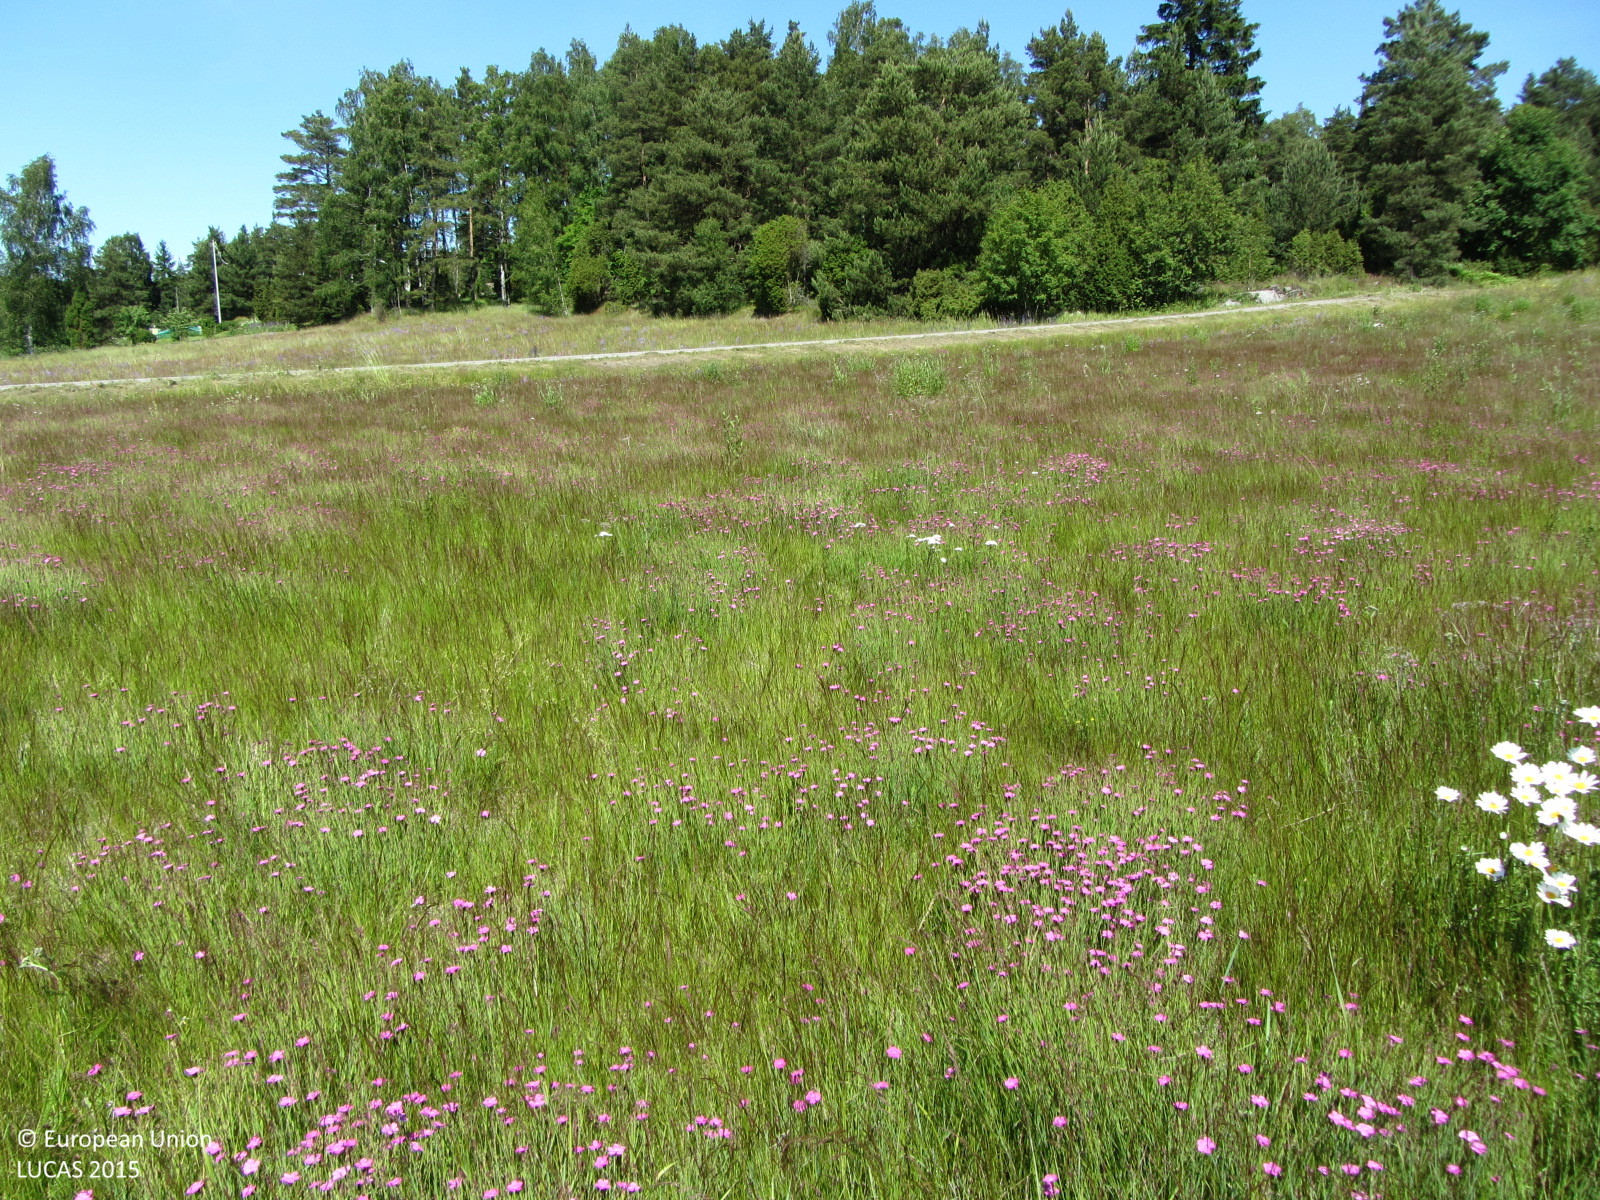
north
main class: Grassland
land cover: Grassland without tree/shrub cover
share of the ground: > 75 %
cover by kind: herbaceous plants 100 %
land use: Agriculture (excluding fallow land and kitchen gardens)
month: July
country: FI
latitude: 59.9260
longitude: 23.1623
